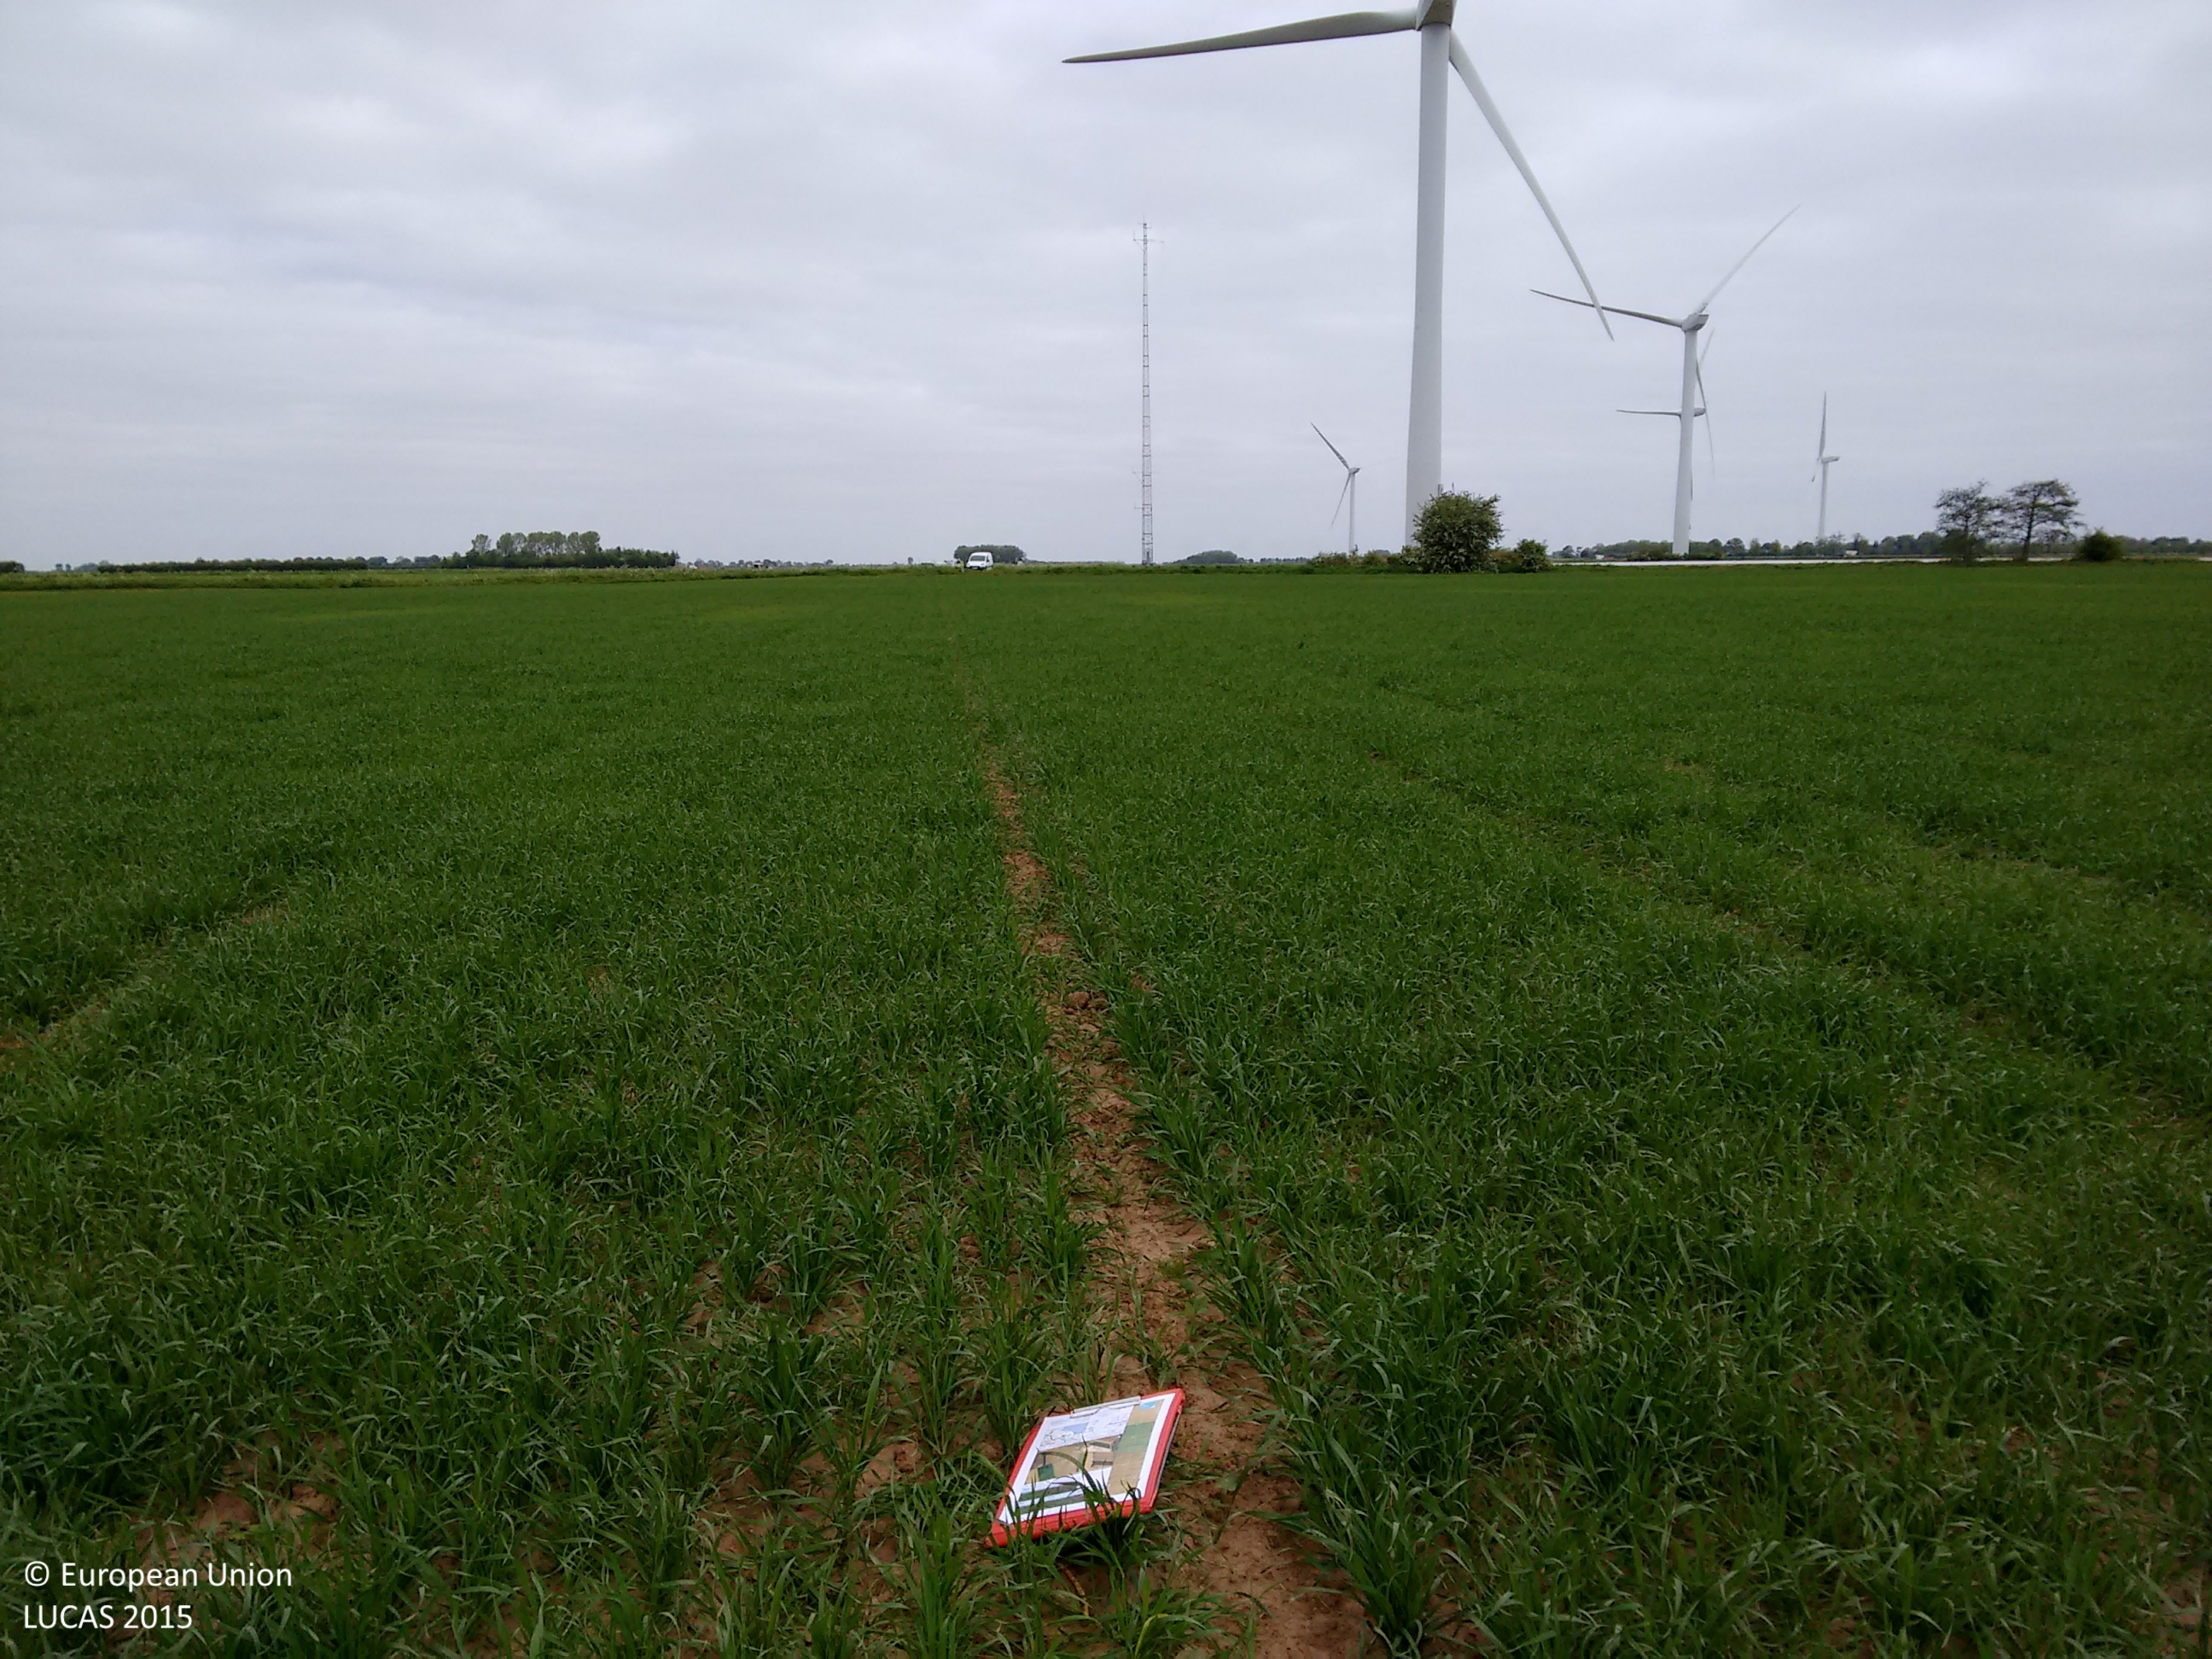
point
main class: Cropland
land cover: Common wheat
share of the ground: > 75 %
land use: Agriculture (excluding fallow land and kitchen gardens)
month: May
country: GB
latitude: 52.8321
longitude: 0.0981
